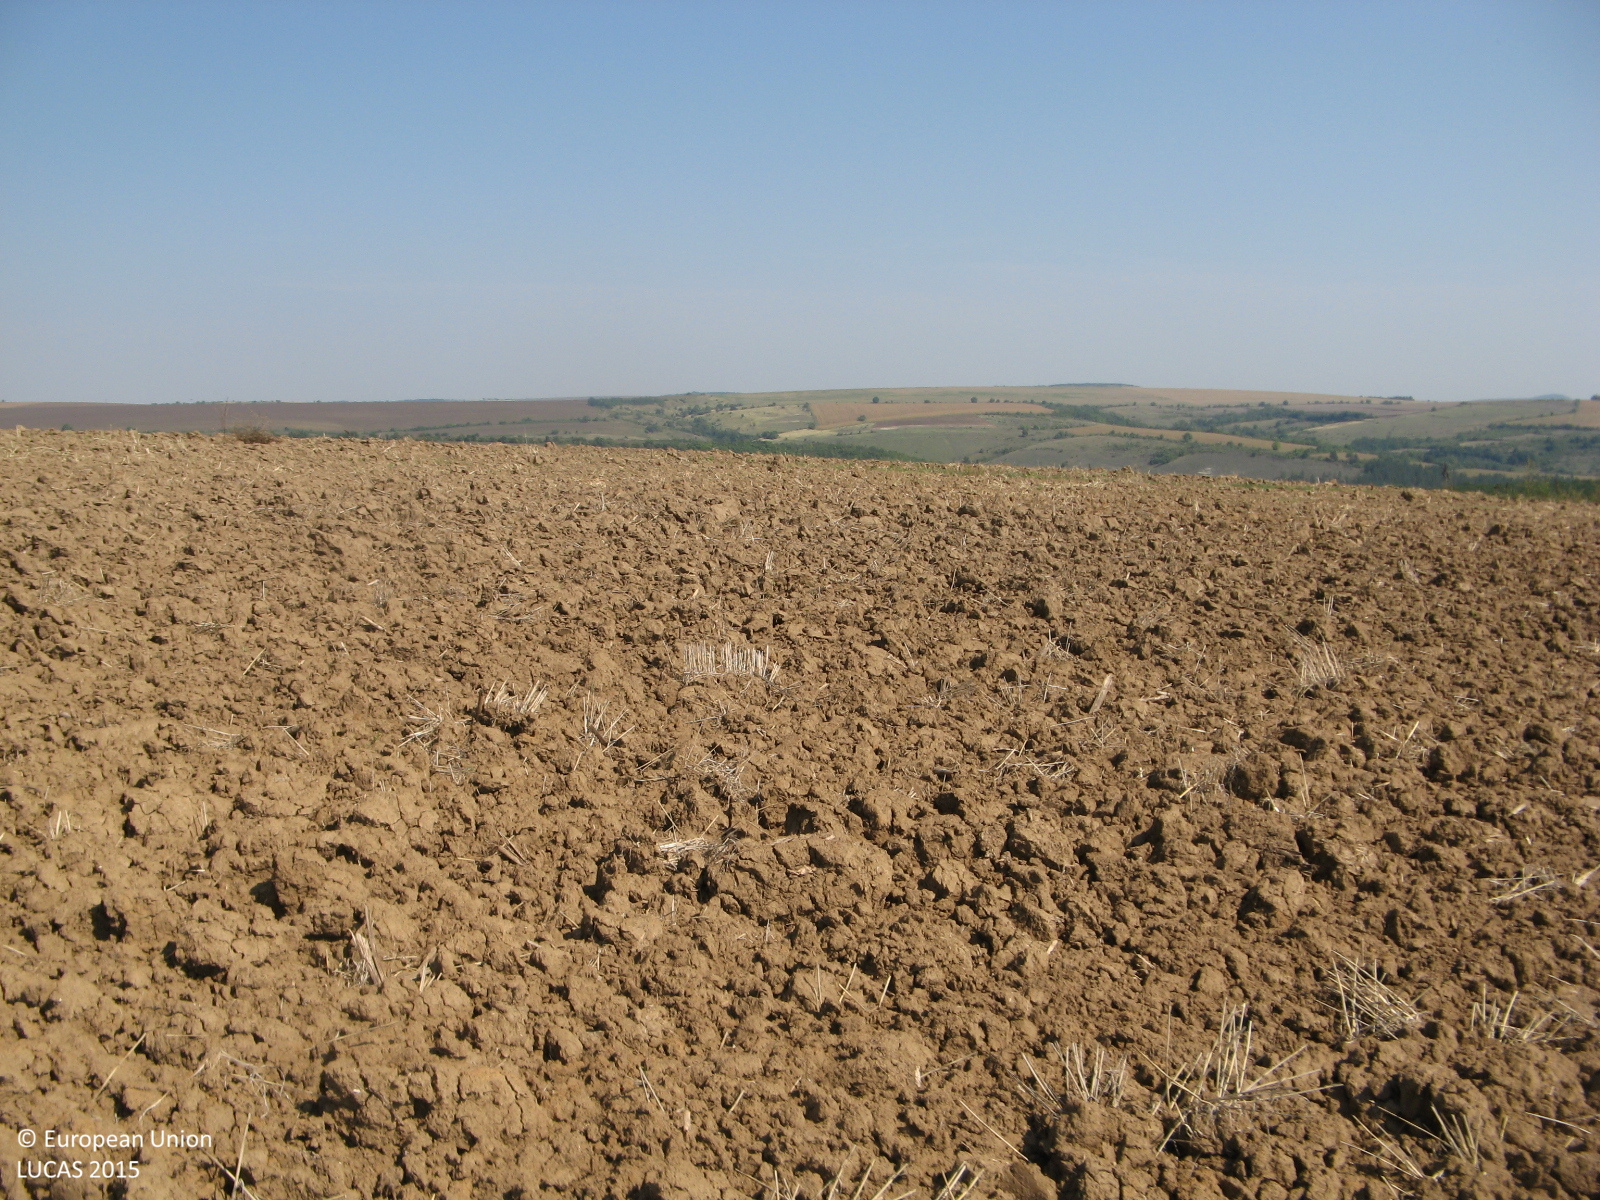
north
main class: Cropland
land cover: Common wheat
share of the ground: < 10 %
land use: Agriculture (excluding fallow land and kitchen gardens)
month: August
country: BG
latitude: 43.4680
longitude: 25.8744
